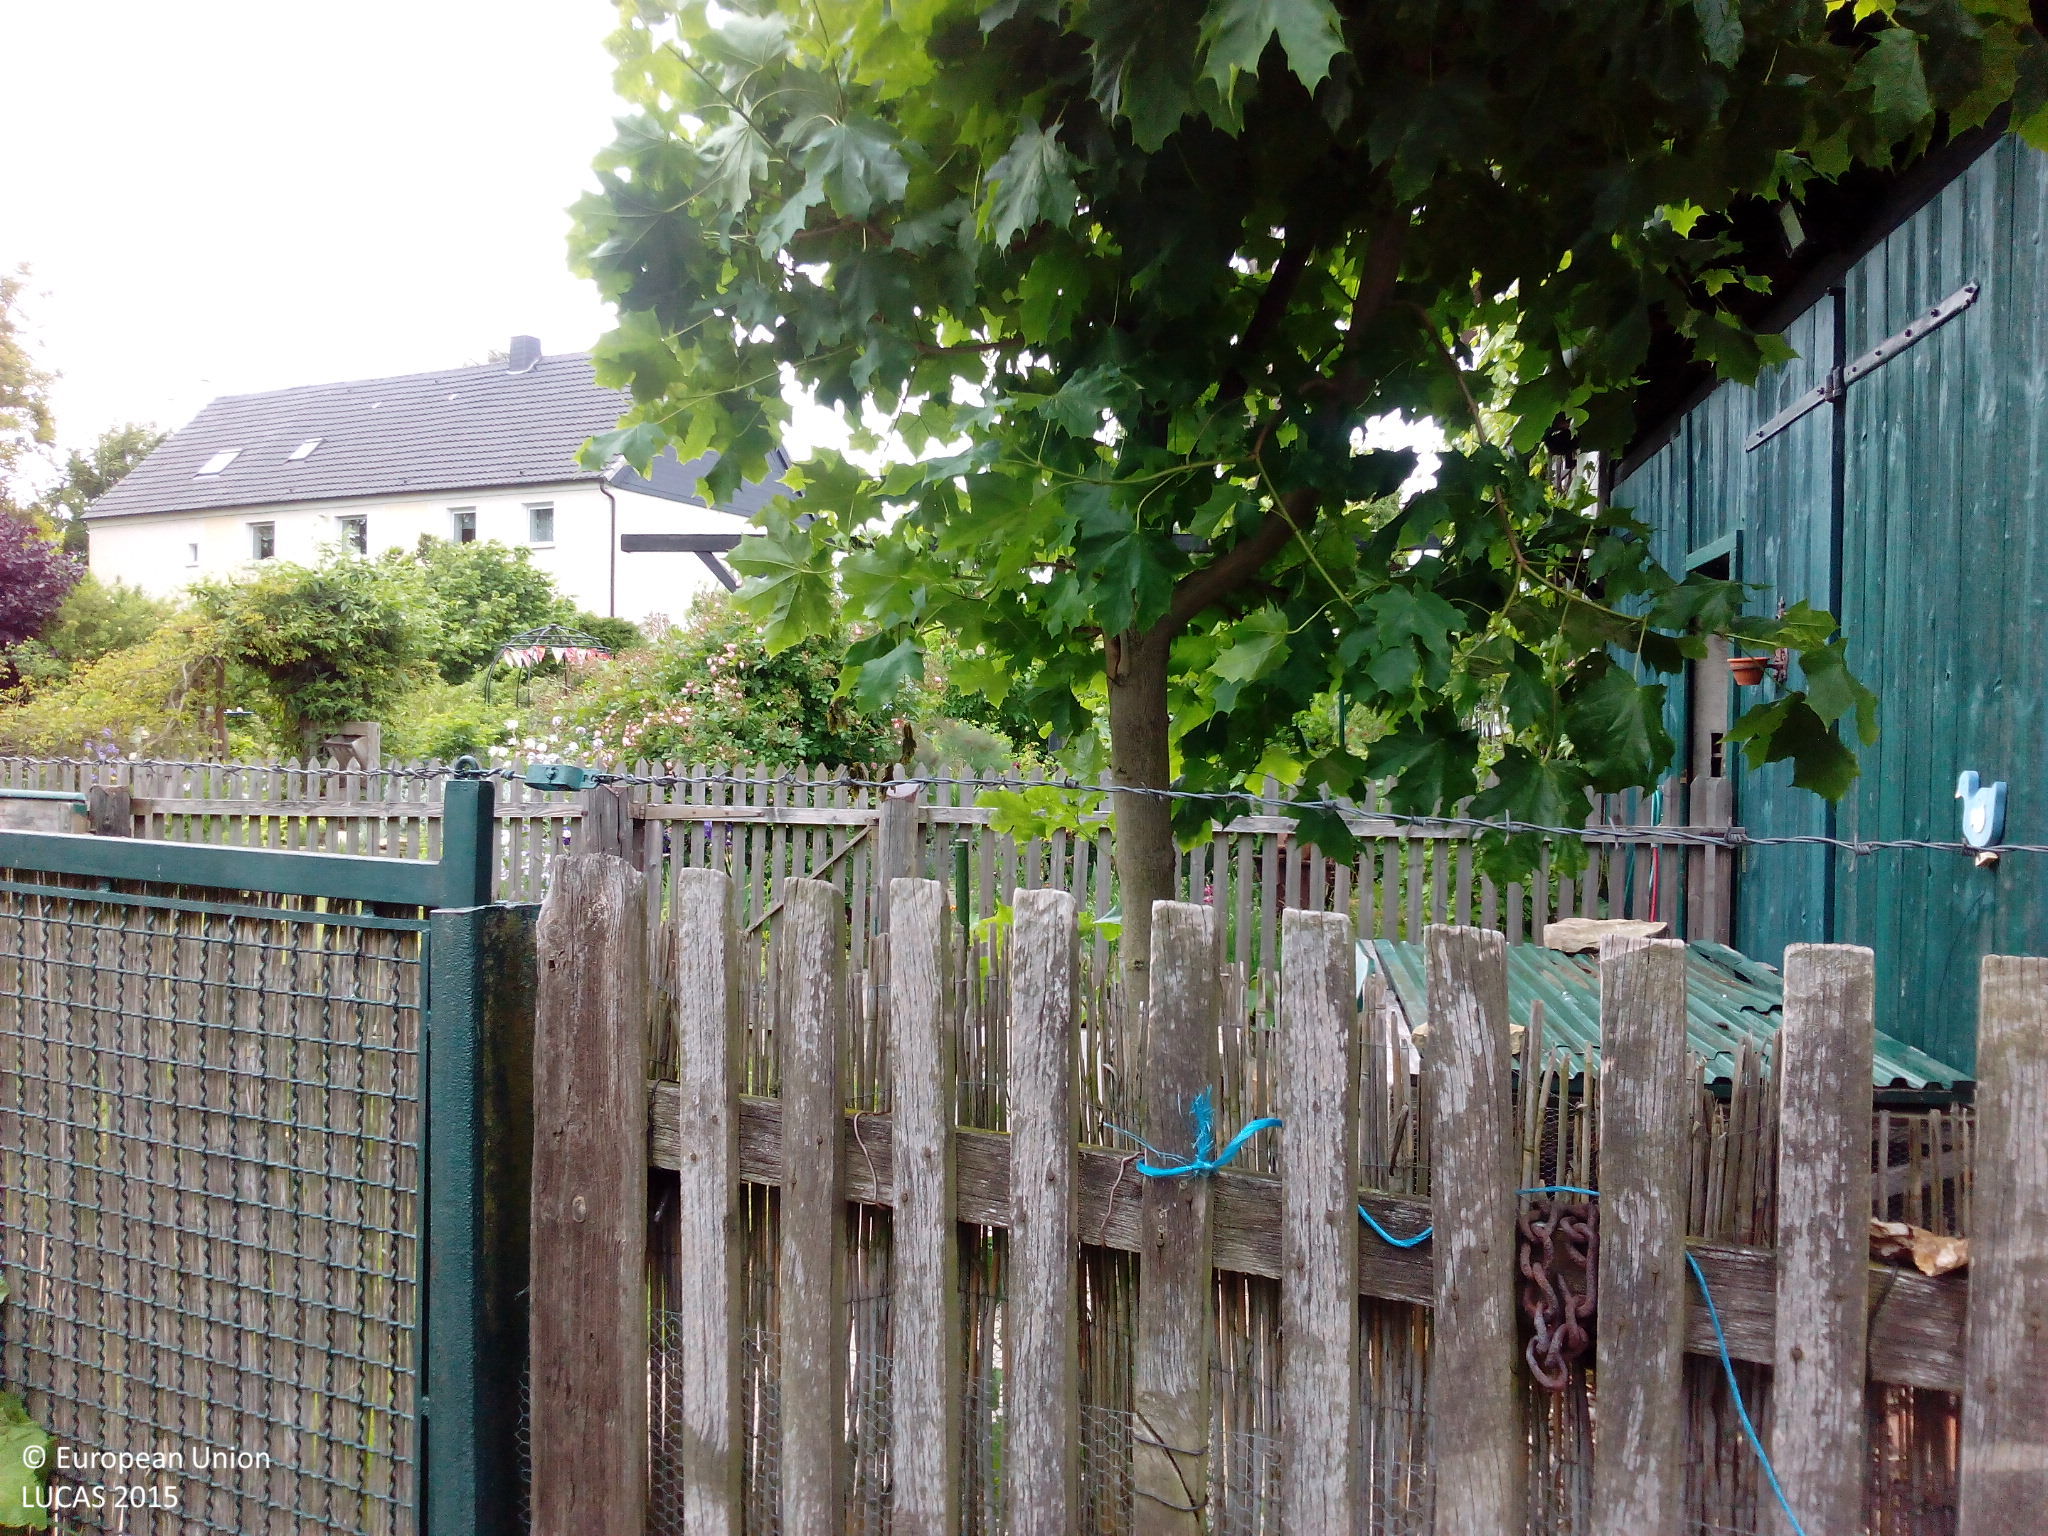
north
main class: Cropland
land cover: Floriculture and ornamental plants
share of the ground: > 75 %
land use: Residential
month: June
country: DE
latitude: 51.5514
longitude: 7.9957
